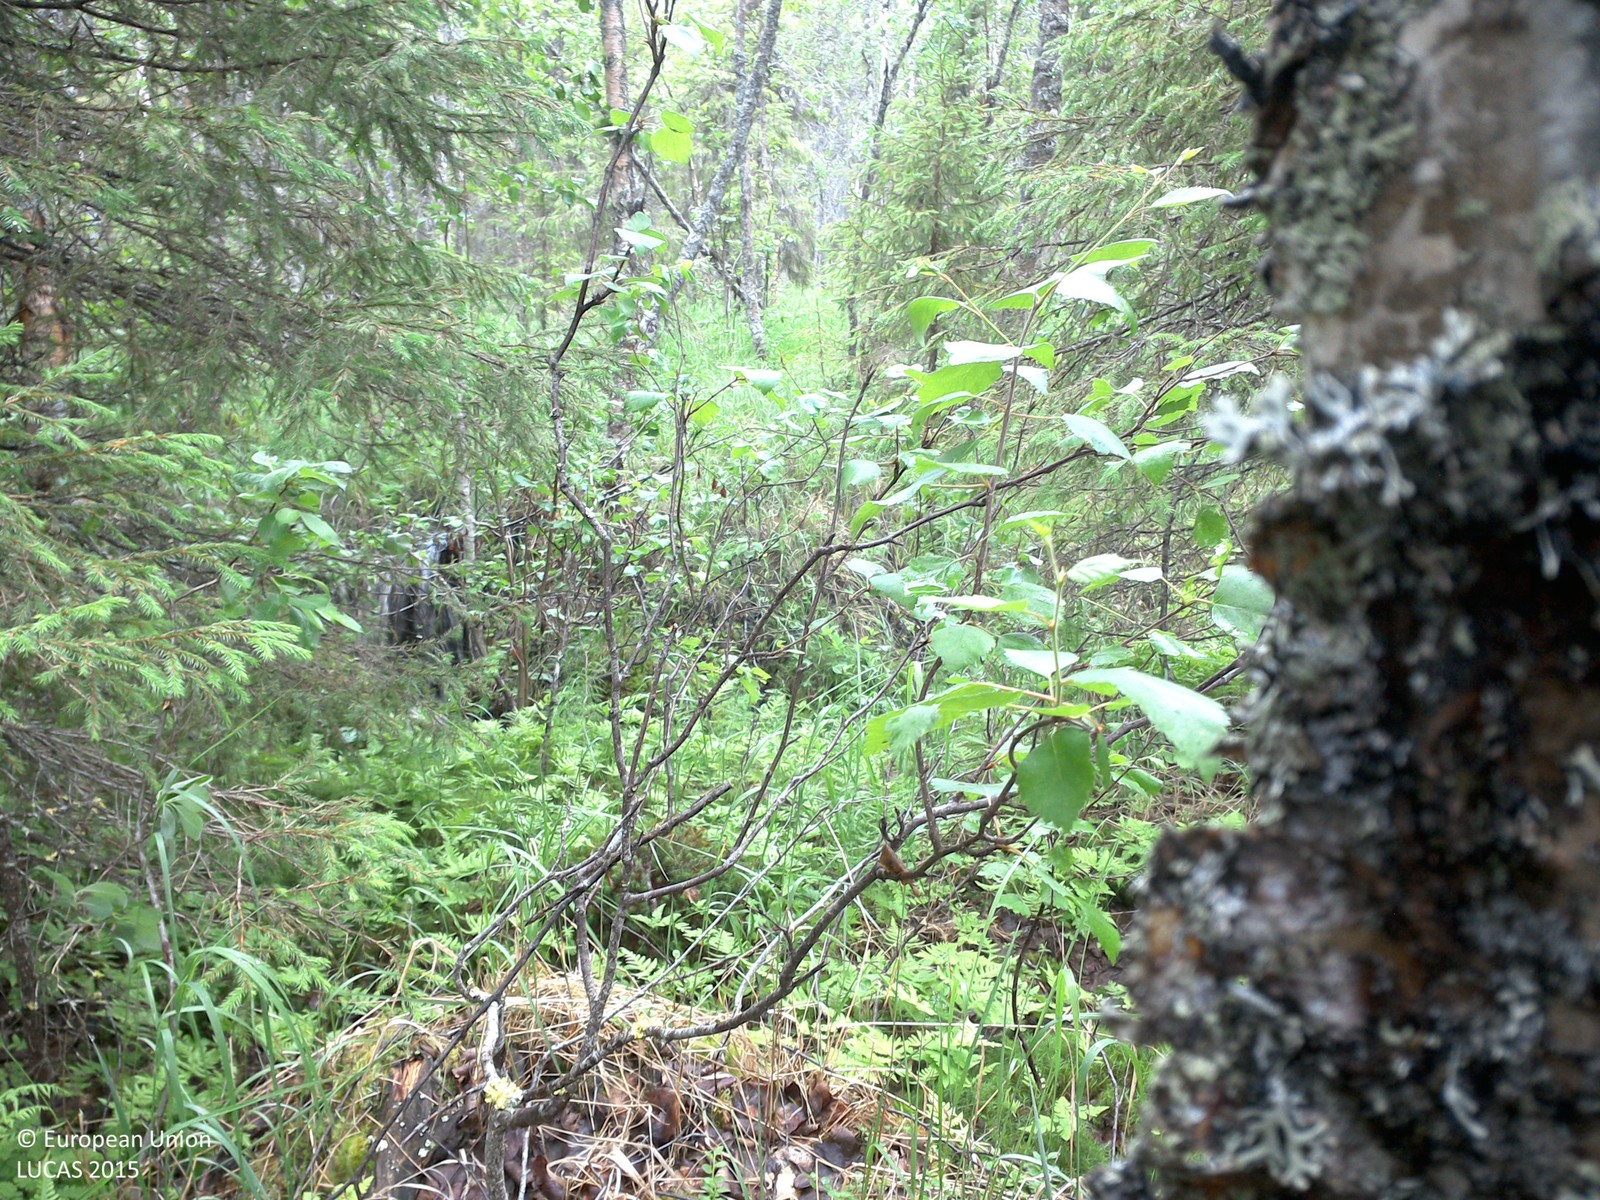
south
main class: Woodland
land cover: Other mixed woodland
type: boreal forest
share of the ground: 25 - 50 %
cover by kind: lichens and mosses 35 %, broadleaved forest trees 30 %, herbaceous plants 25 %, coniferous forest trees 10 %
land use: Forestry
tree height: > 5 m
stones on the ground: < 10 %
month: July
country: SE
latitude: 67.0145
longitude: 23.5860
